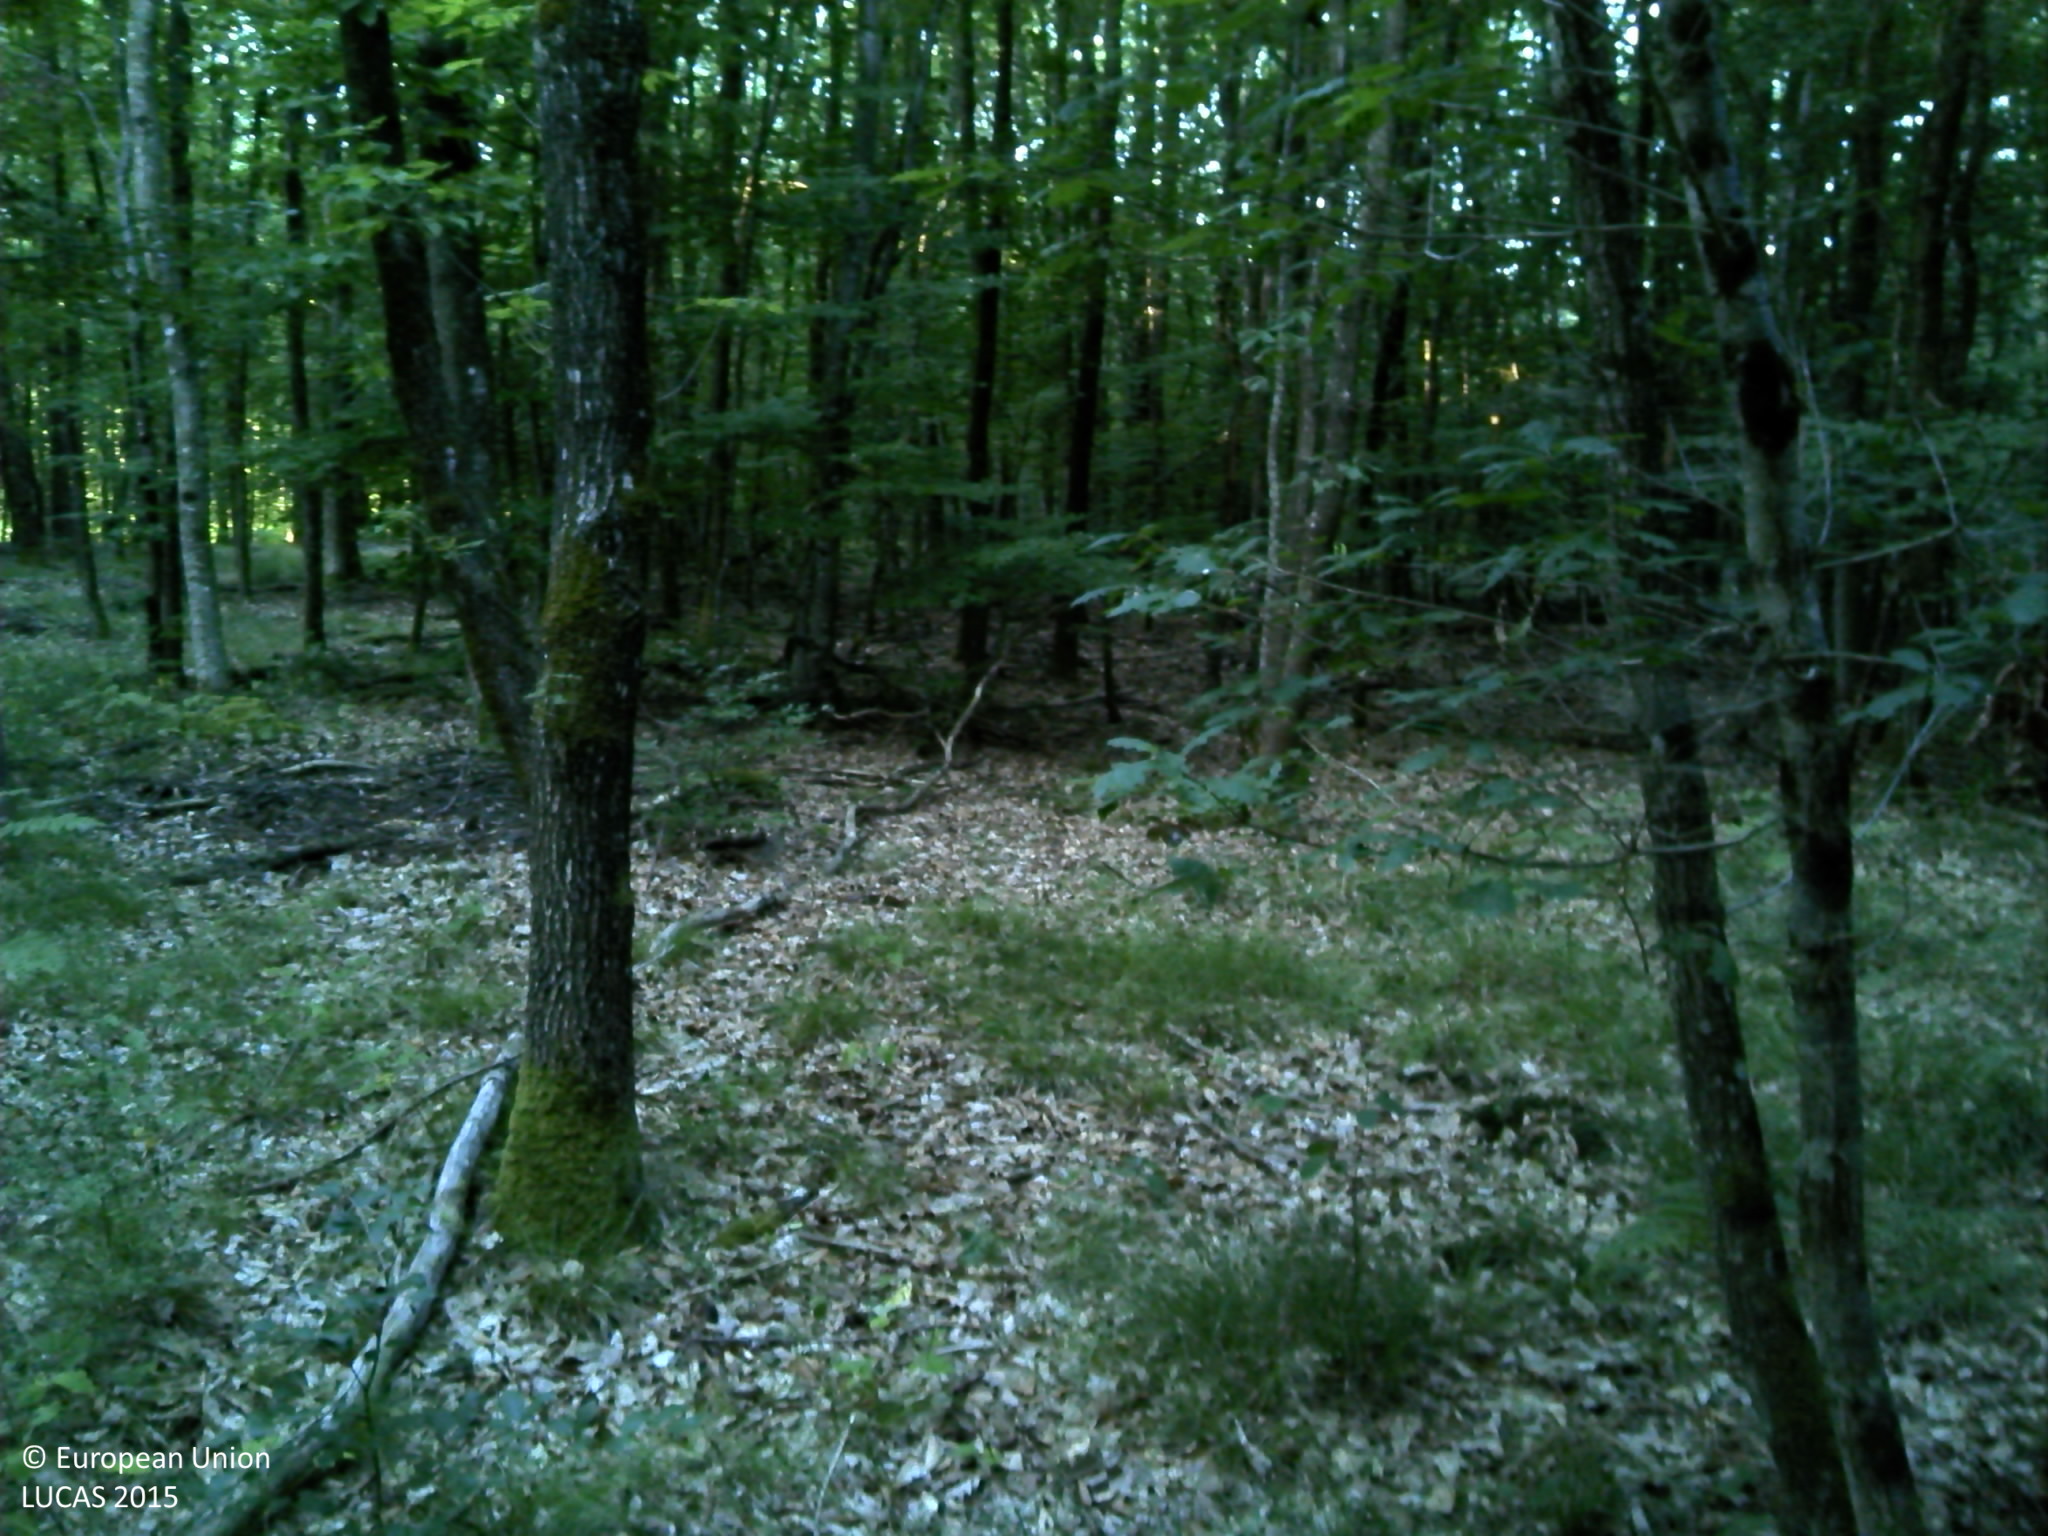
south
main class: Woodland
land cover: Broadleaved woodland
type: acidophilous oak and oak-birch forest
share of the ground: > 75 %
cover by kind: broadleaved forest trees 100 %
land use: Forestry
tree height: > 5 m
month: July
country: FR
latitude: 48.3961
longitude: 6.3132
